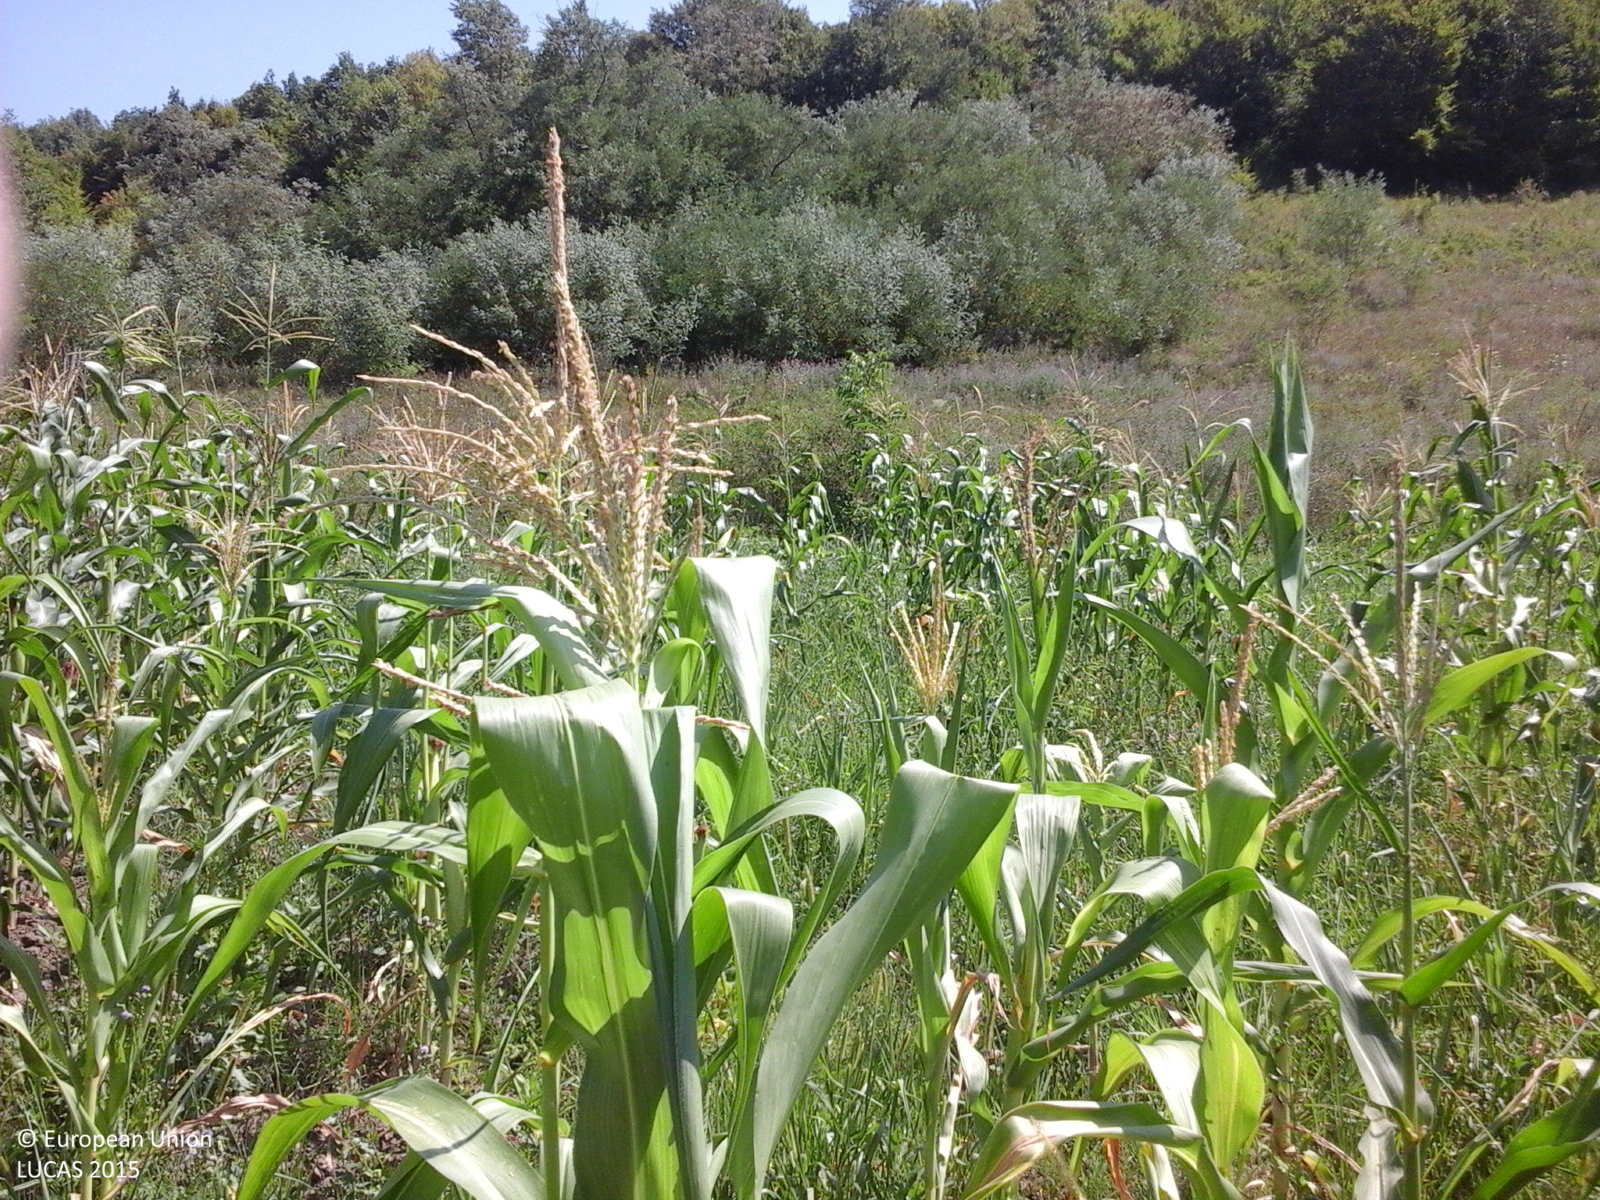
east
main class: Cropland
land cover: Maize
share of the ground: > 75 %
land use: Agriculture (excluding fallow land and kitchen gardens)
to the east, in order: Maize; Spontaneously vegetated surfaces; Broadleaved woodland; Shrubland with sparse tree cover; Grassland without tree/shrub cover
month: July
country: RO
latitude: 46.5063
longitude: 27.2128
